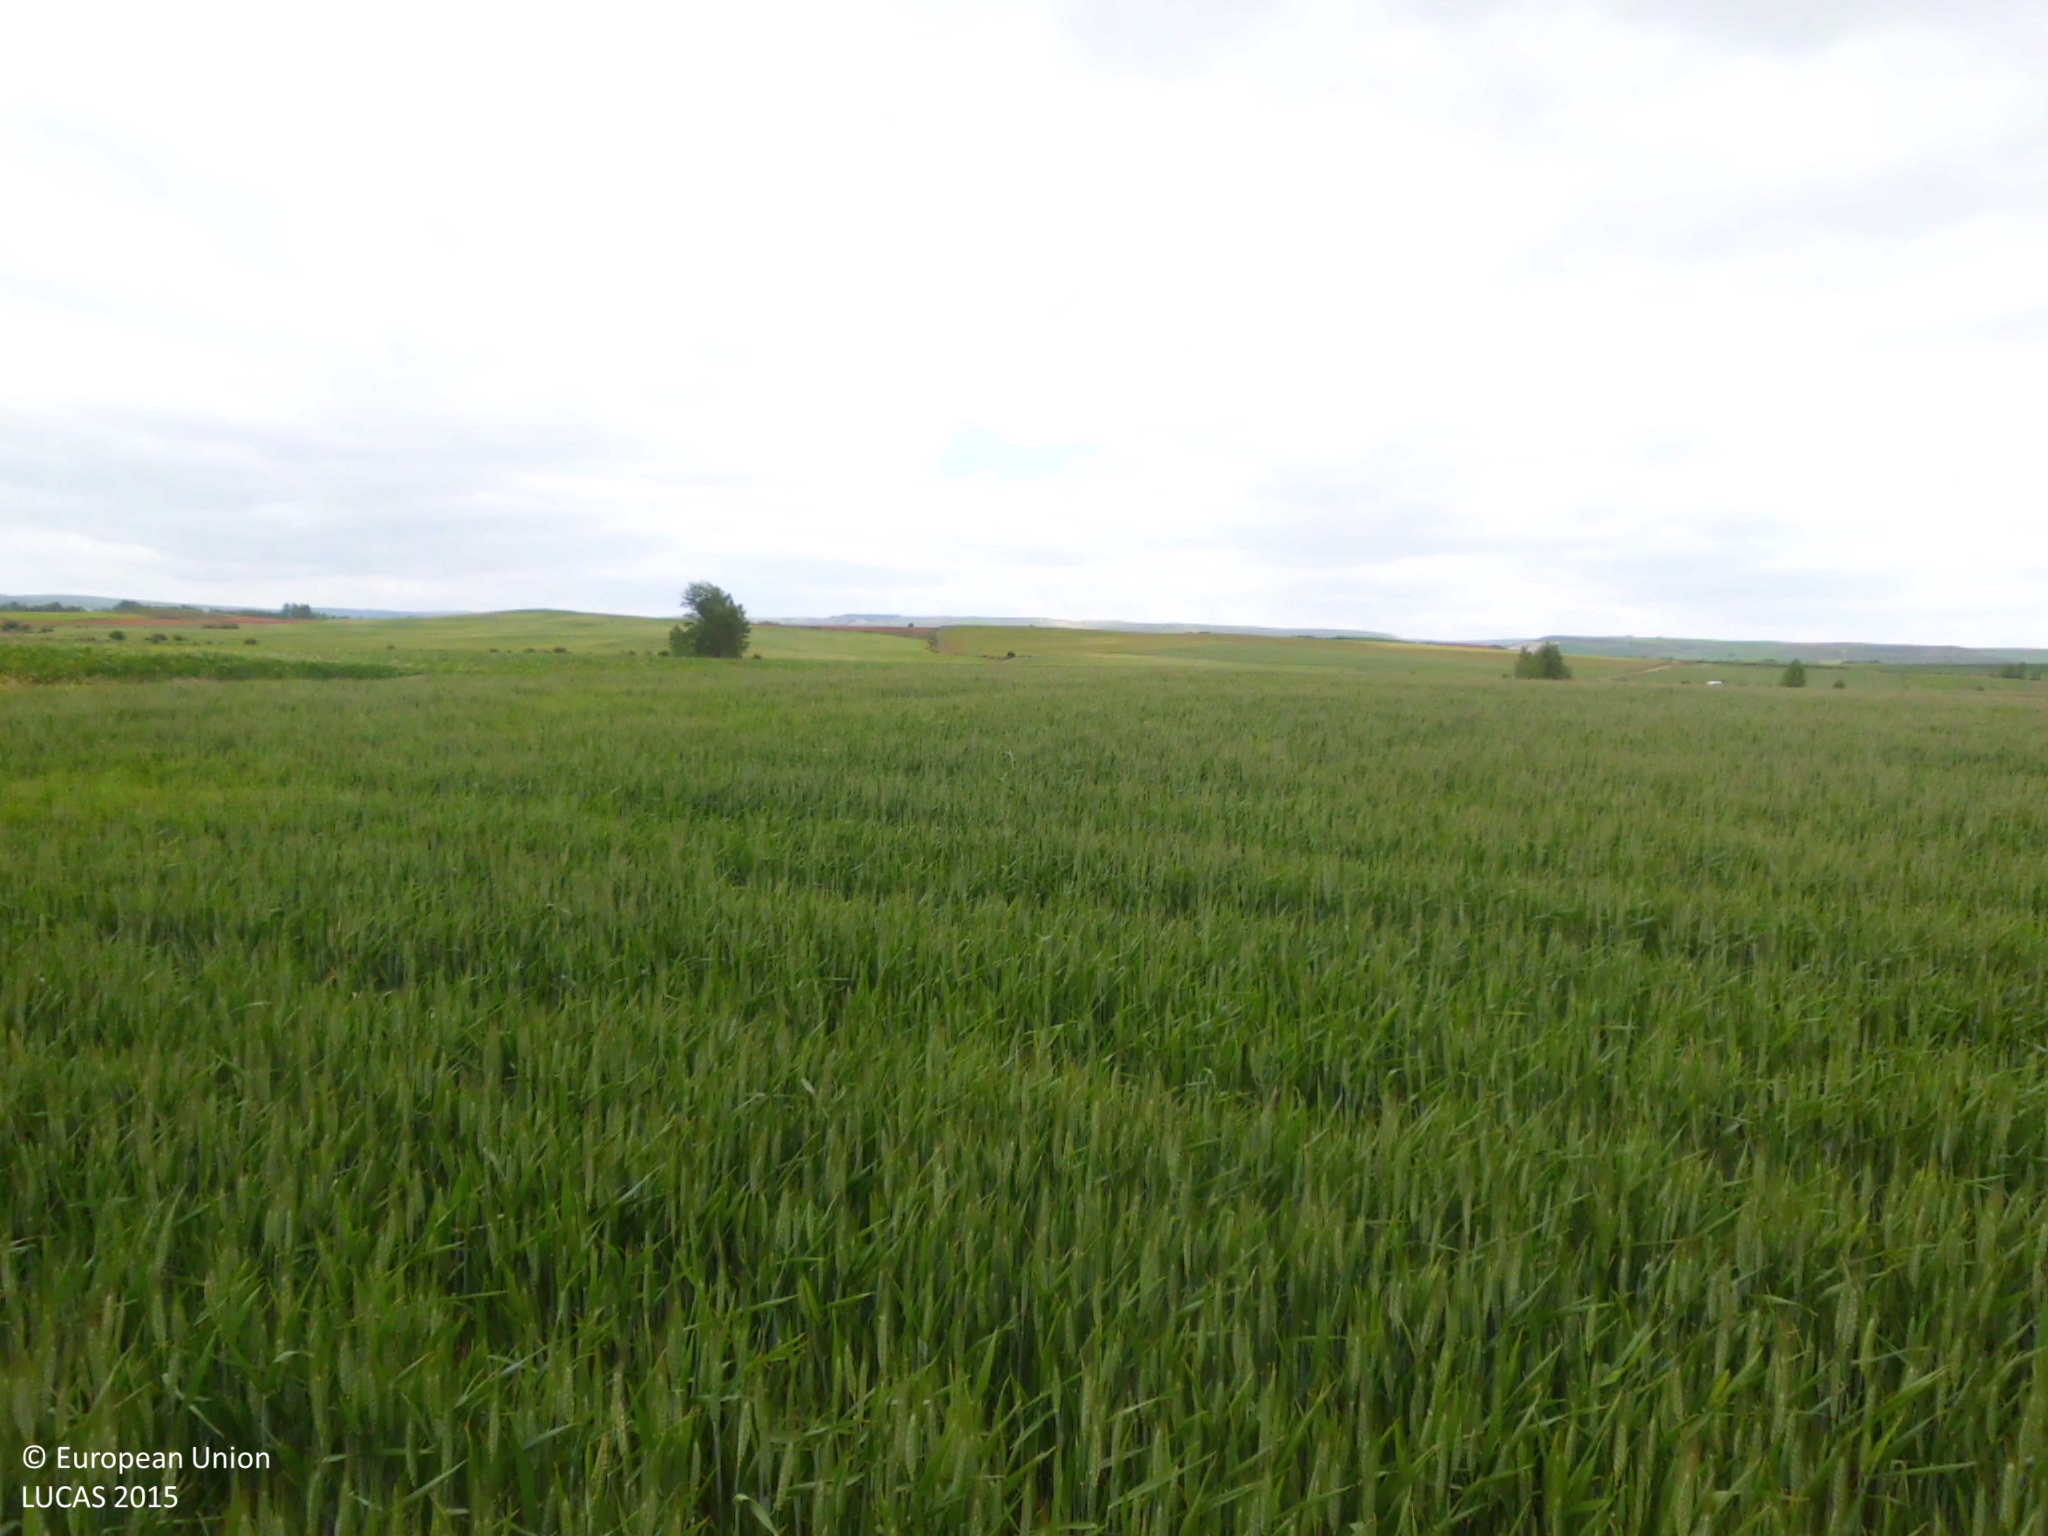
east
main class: Cropland
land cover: Barley
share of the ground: > 75 %
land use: Agriculture (excluding fallow land and kitchen gardens)
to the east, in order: Barley; Tracks; Barley
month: May
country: ES
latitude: 42.5352
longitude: -4.0083
